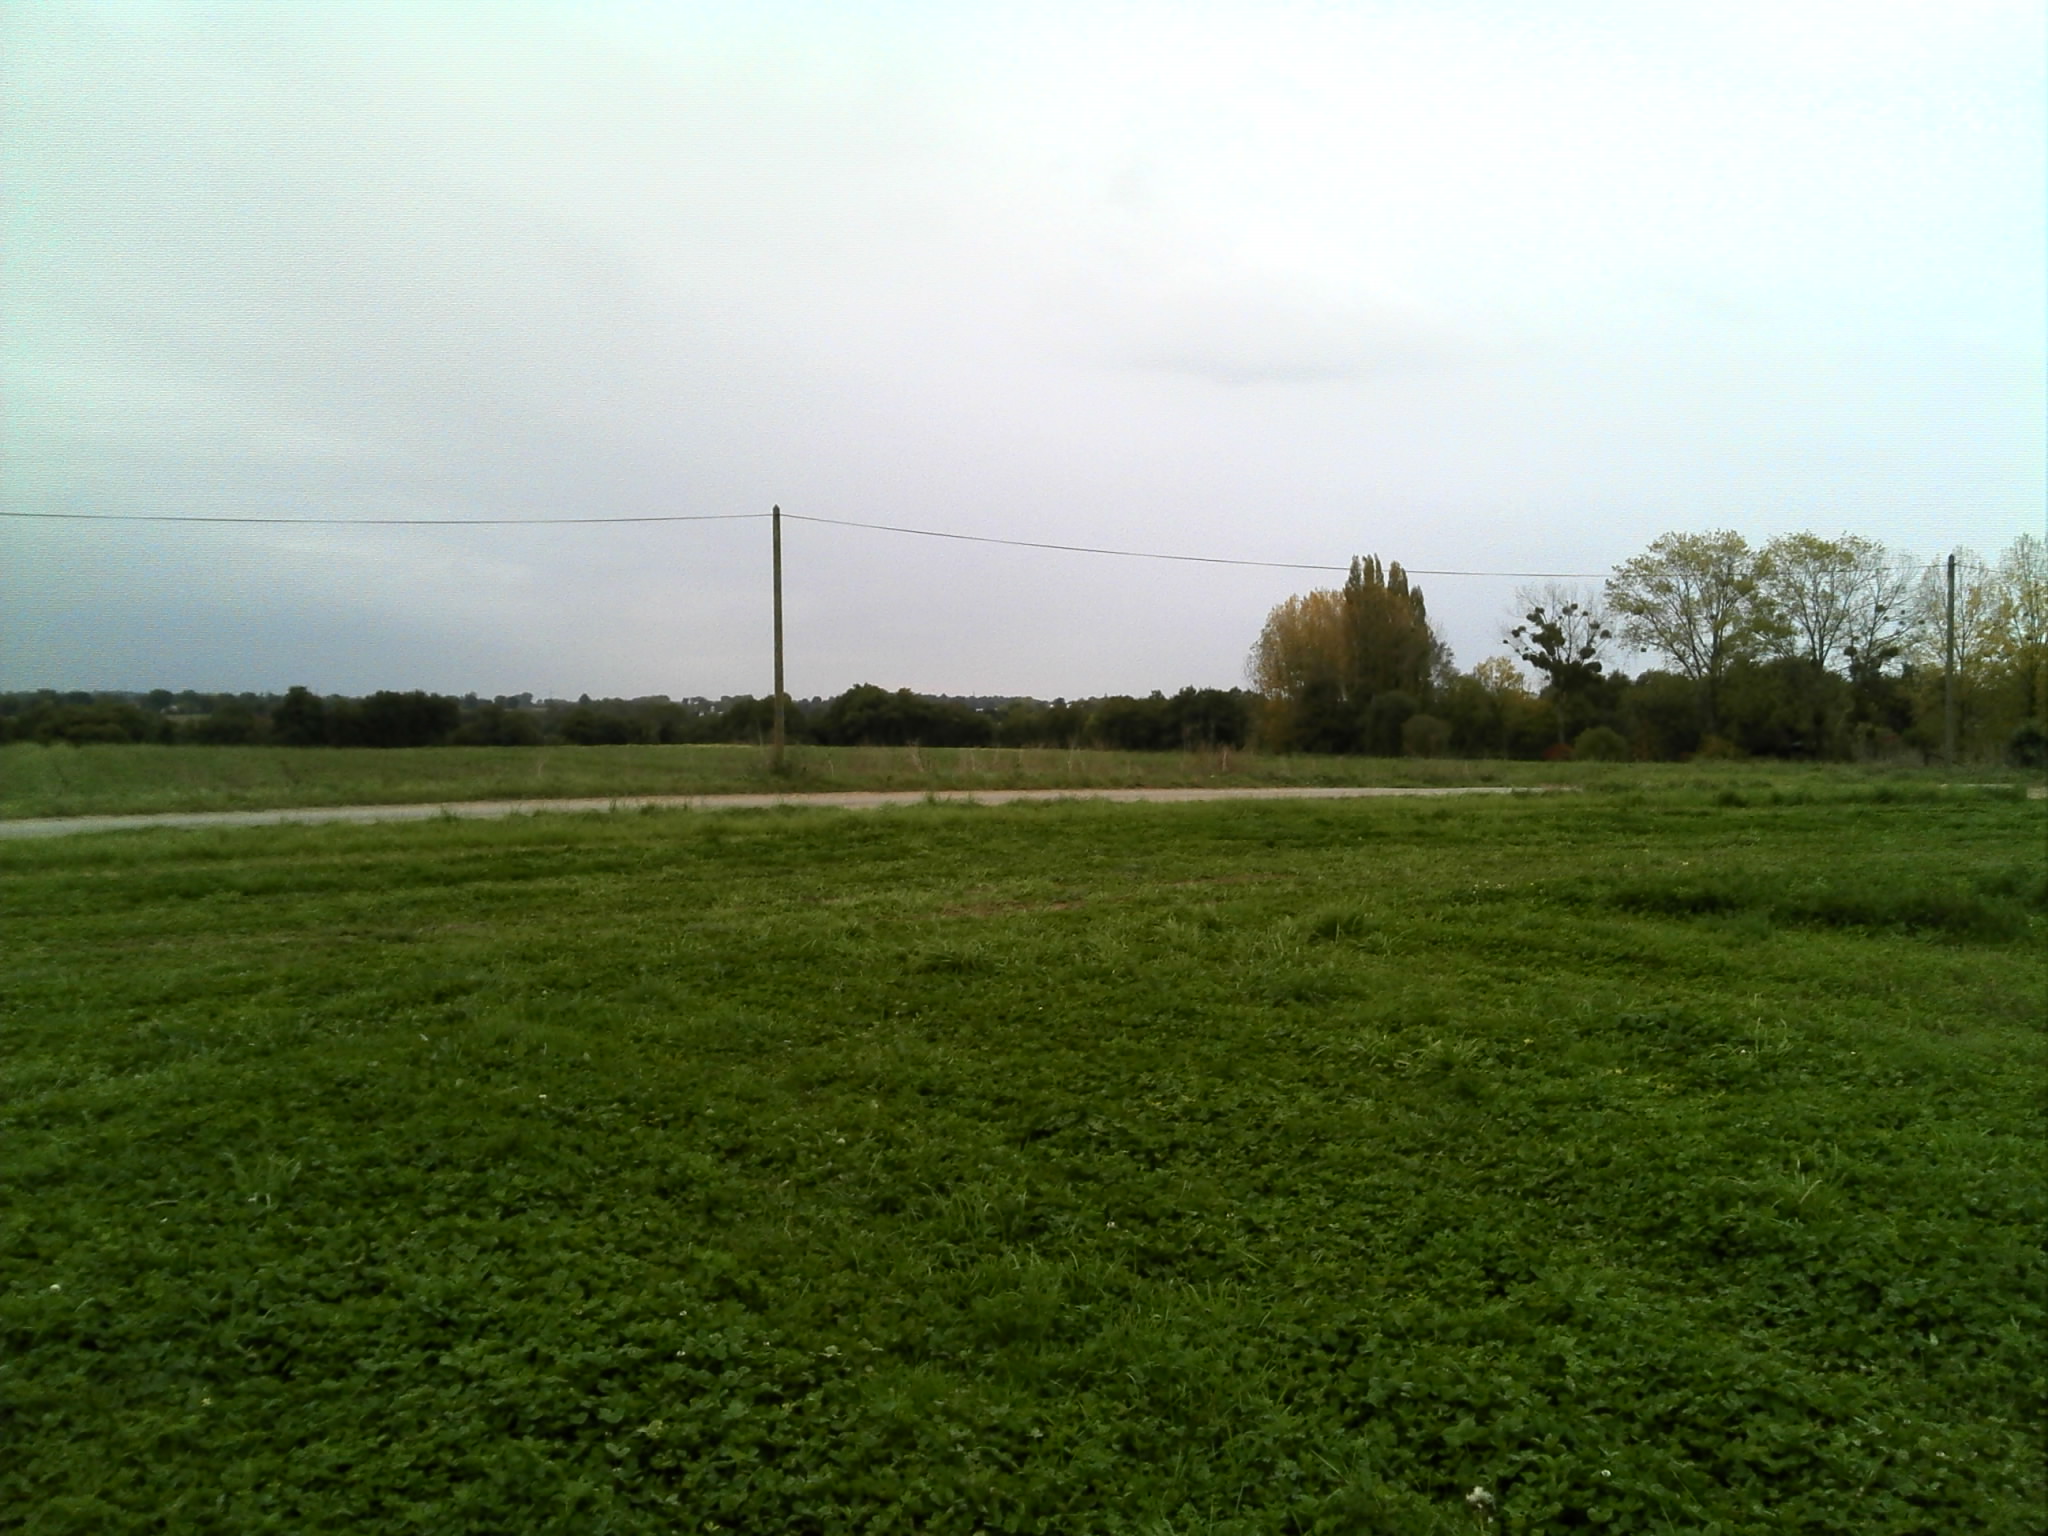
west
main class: Cropland
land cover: Clovers
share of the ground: > 75 %
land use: Agriculture (excluding fallow land and kitchen gardens)
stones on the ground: 10 - 25 %
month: October
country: FR
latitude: 47.2632
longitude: -1.2591
